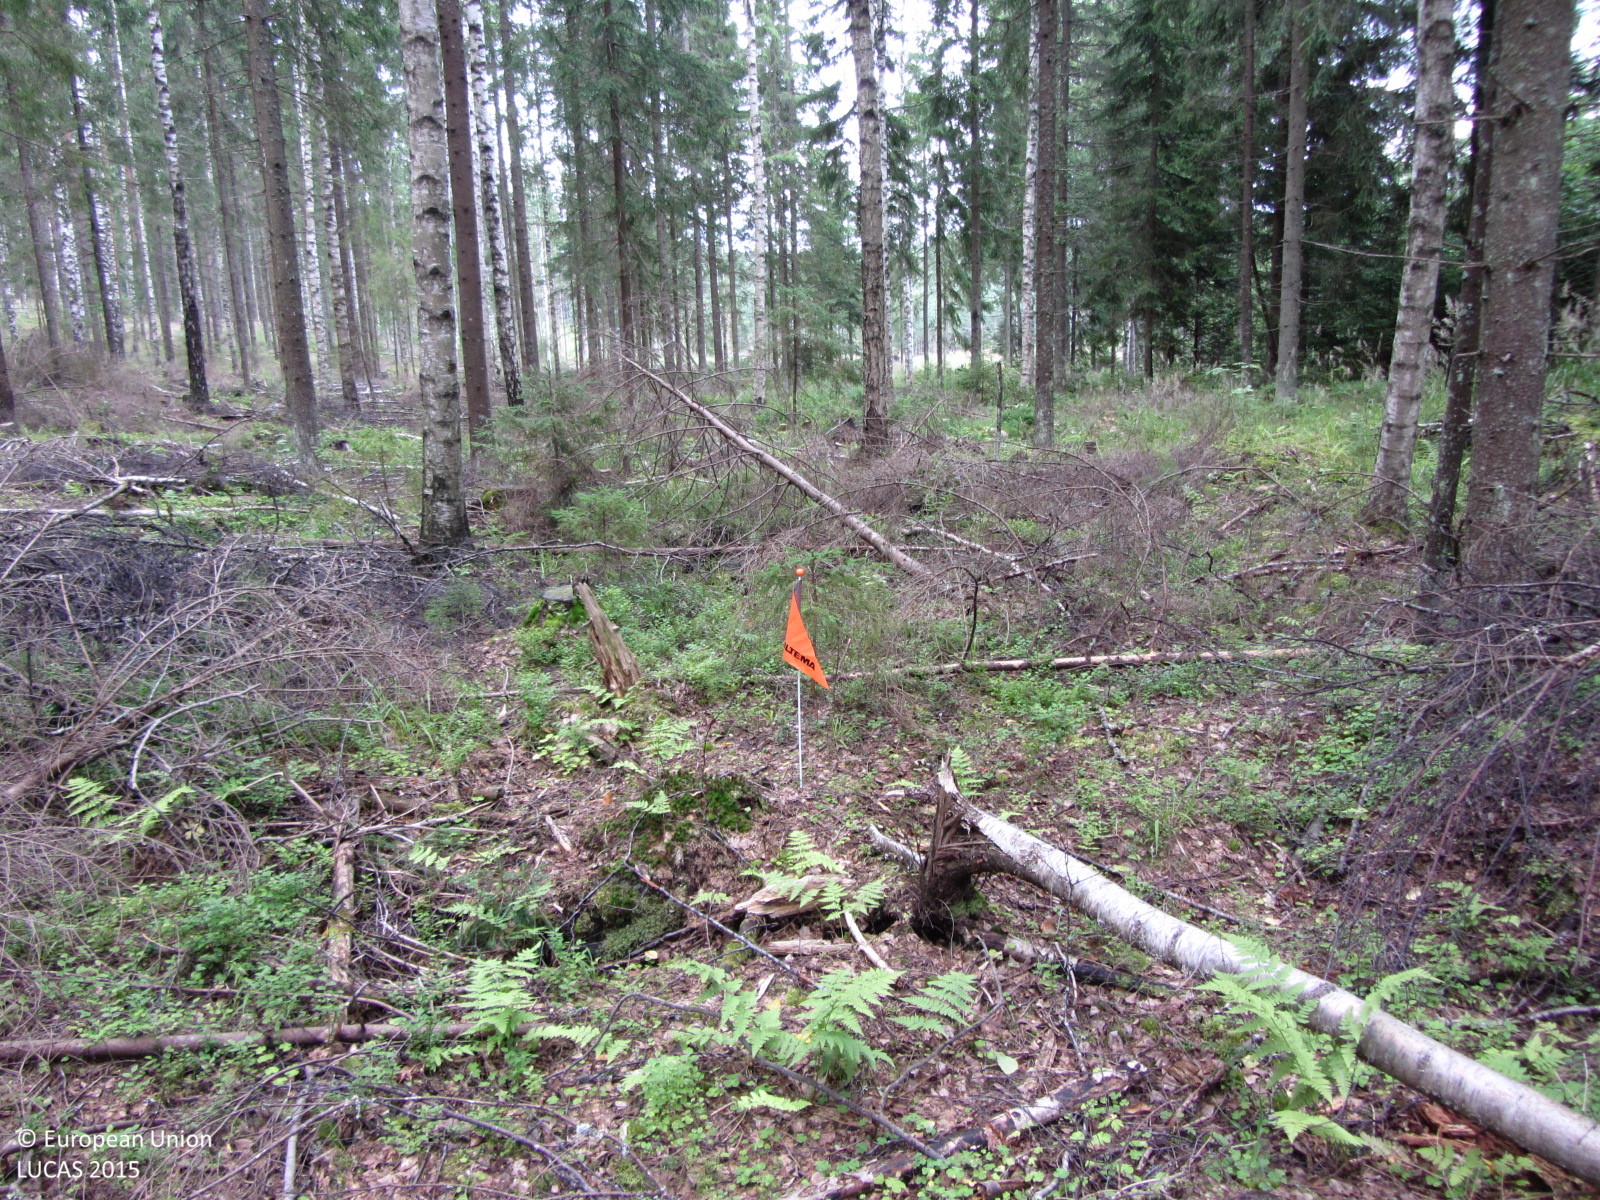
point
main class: Woodland
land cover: Spruce dominated mixed woodland
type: boreal forest
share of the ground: > 75 %
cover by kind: coniferous forest trees 50 %, broadleaved forest trees 25 %, shrubs 10 %, herbaceous plants 10 %, lichens and mosses 5 %
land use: Forestry
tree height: > 5 m
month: July
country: FI
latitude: 60.5753
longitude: 24.2052
